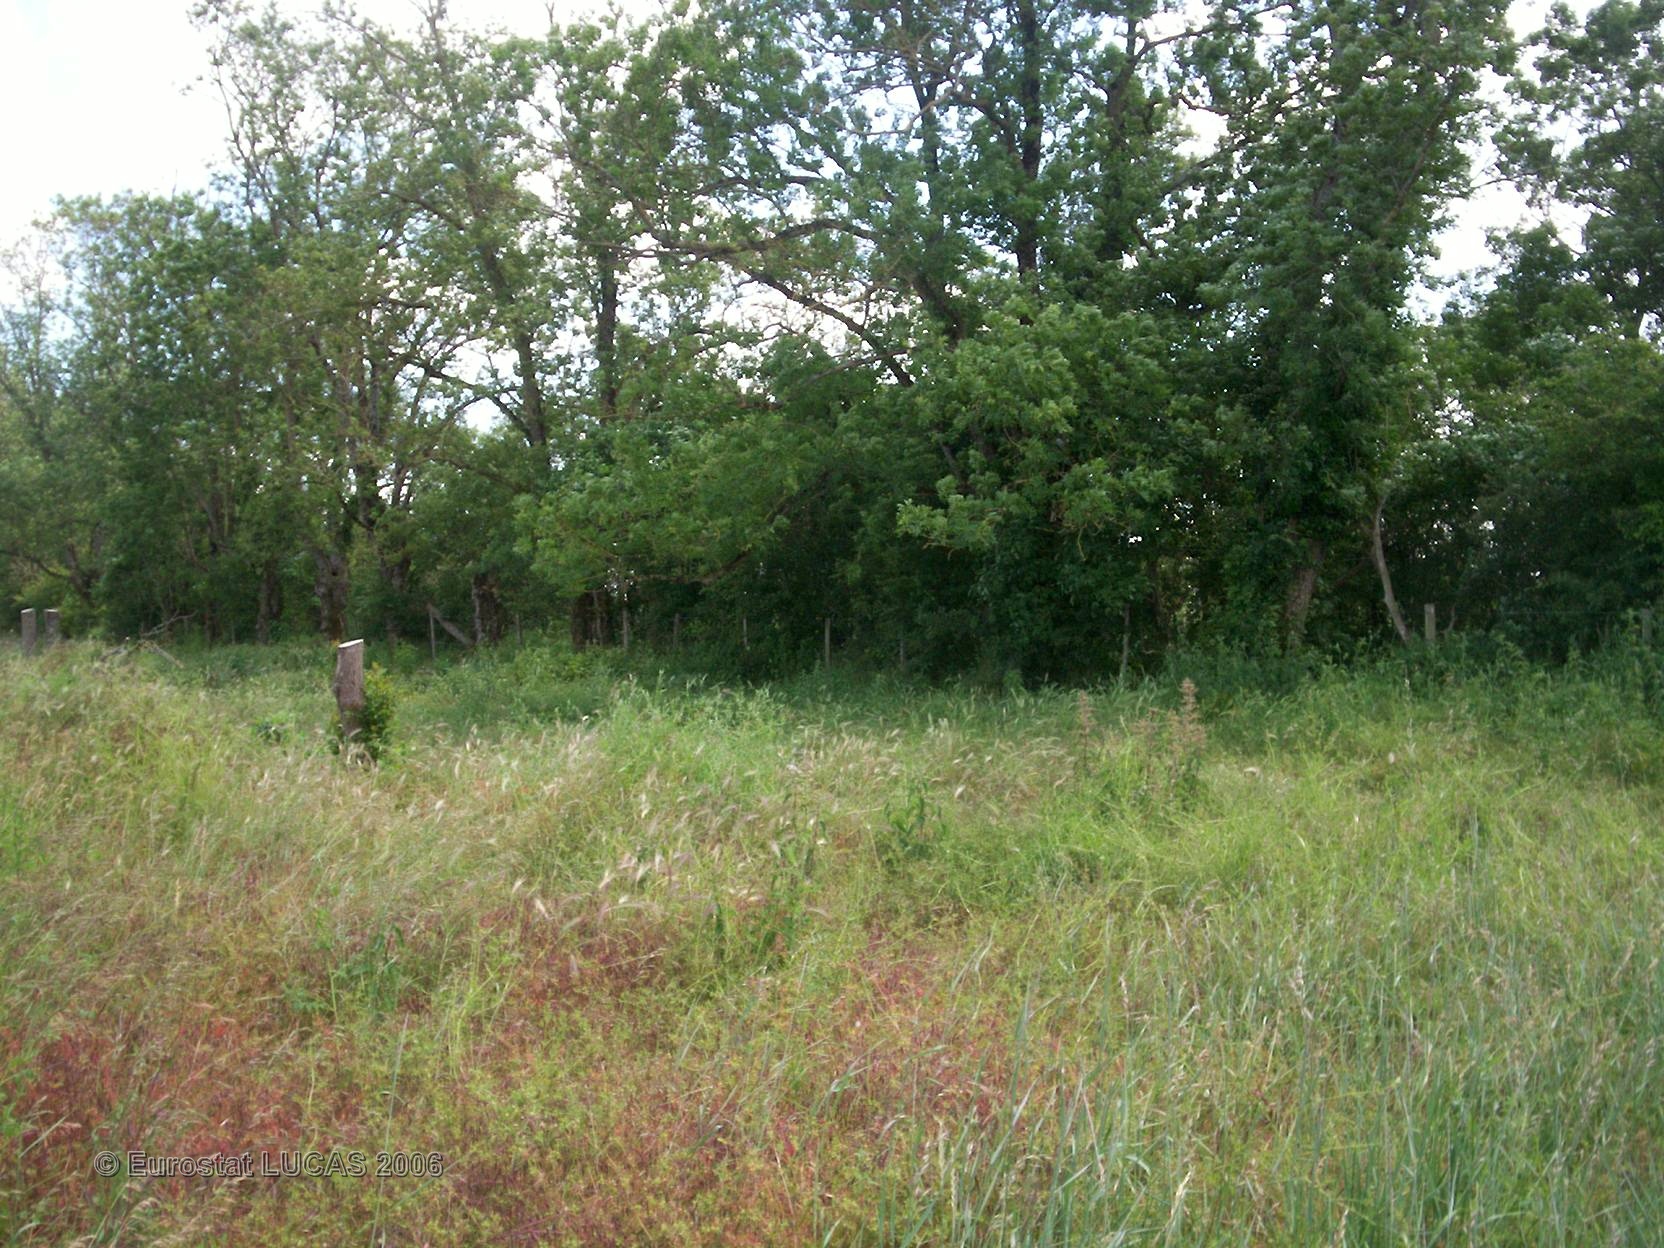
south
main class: Grassland
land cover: Grassland with sparse tree/shrub cover
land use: Agriculture (excluding fallow land and kitchen gardens)
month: June
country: FR
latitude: 46.1895
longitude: -0.9261
